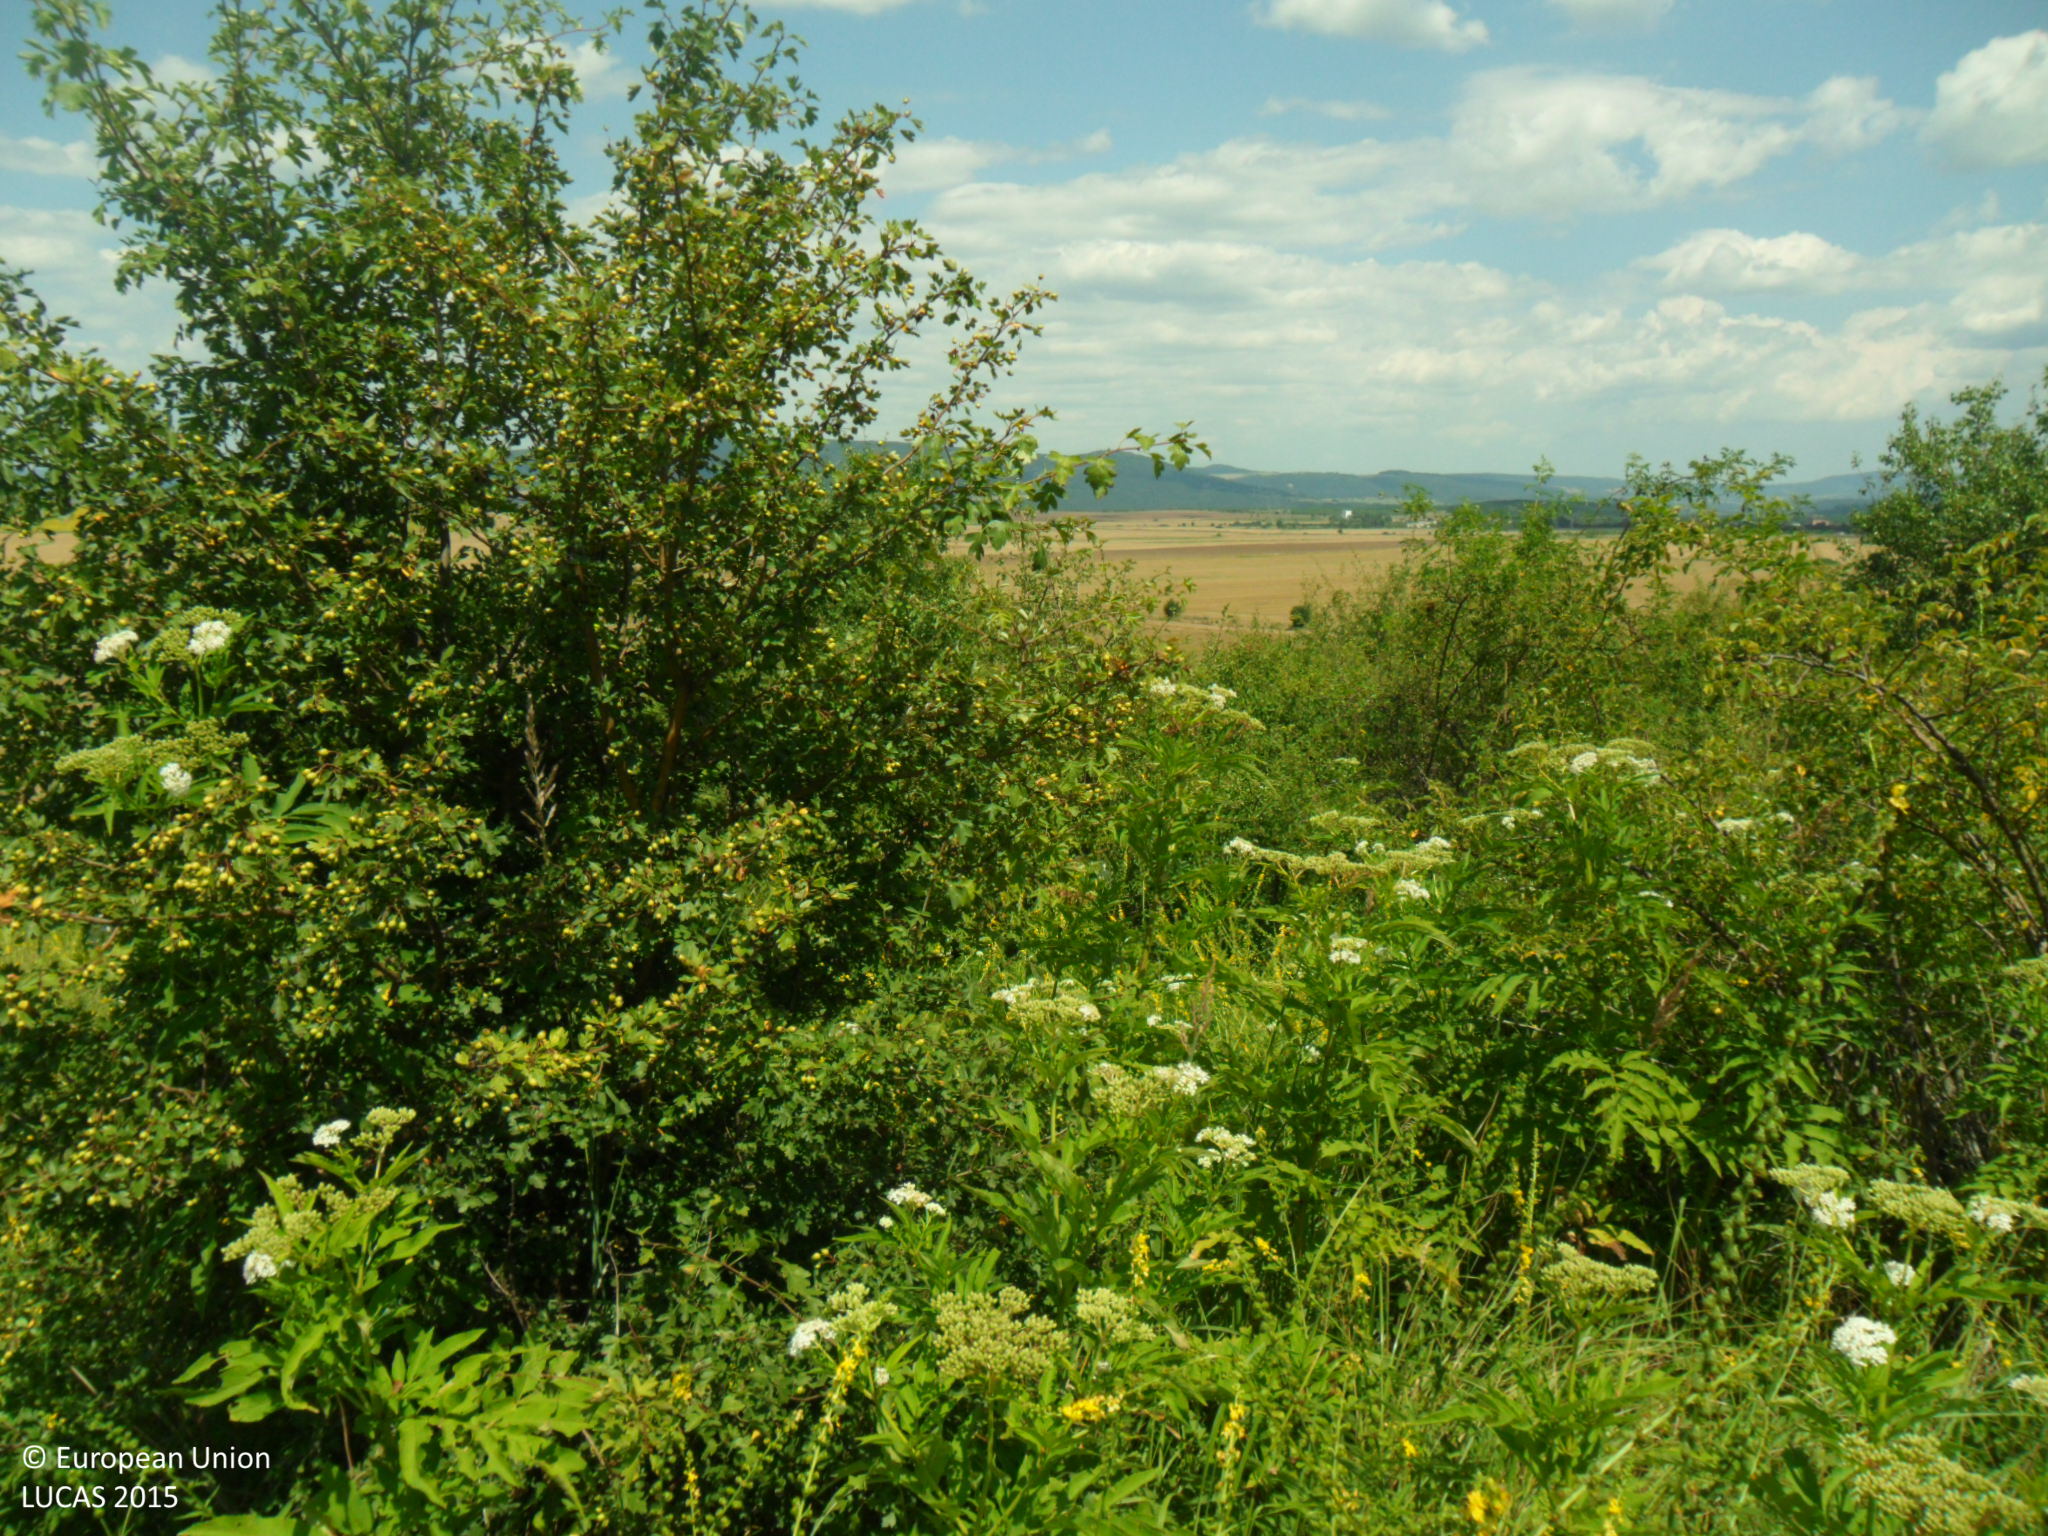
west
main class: Woodland
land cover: Broadleaved woodland
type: mesophytic deciduous forest
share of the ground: > 75 %
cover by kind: broadleaved forest trees 80 %, shrubs 15 %, herbaceous plants 5 %
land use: Forestry
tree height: < 5 m
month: July
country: BG
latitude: 43.0687
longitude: 26.9723
